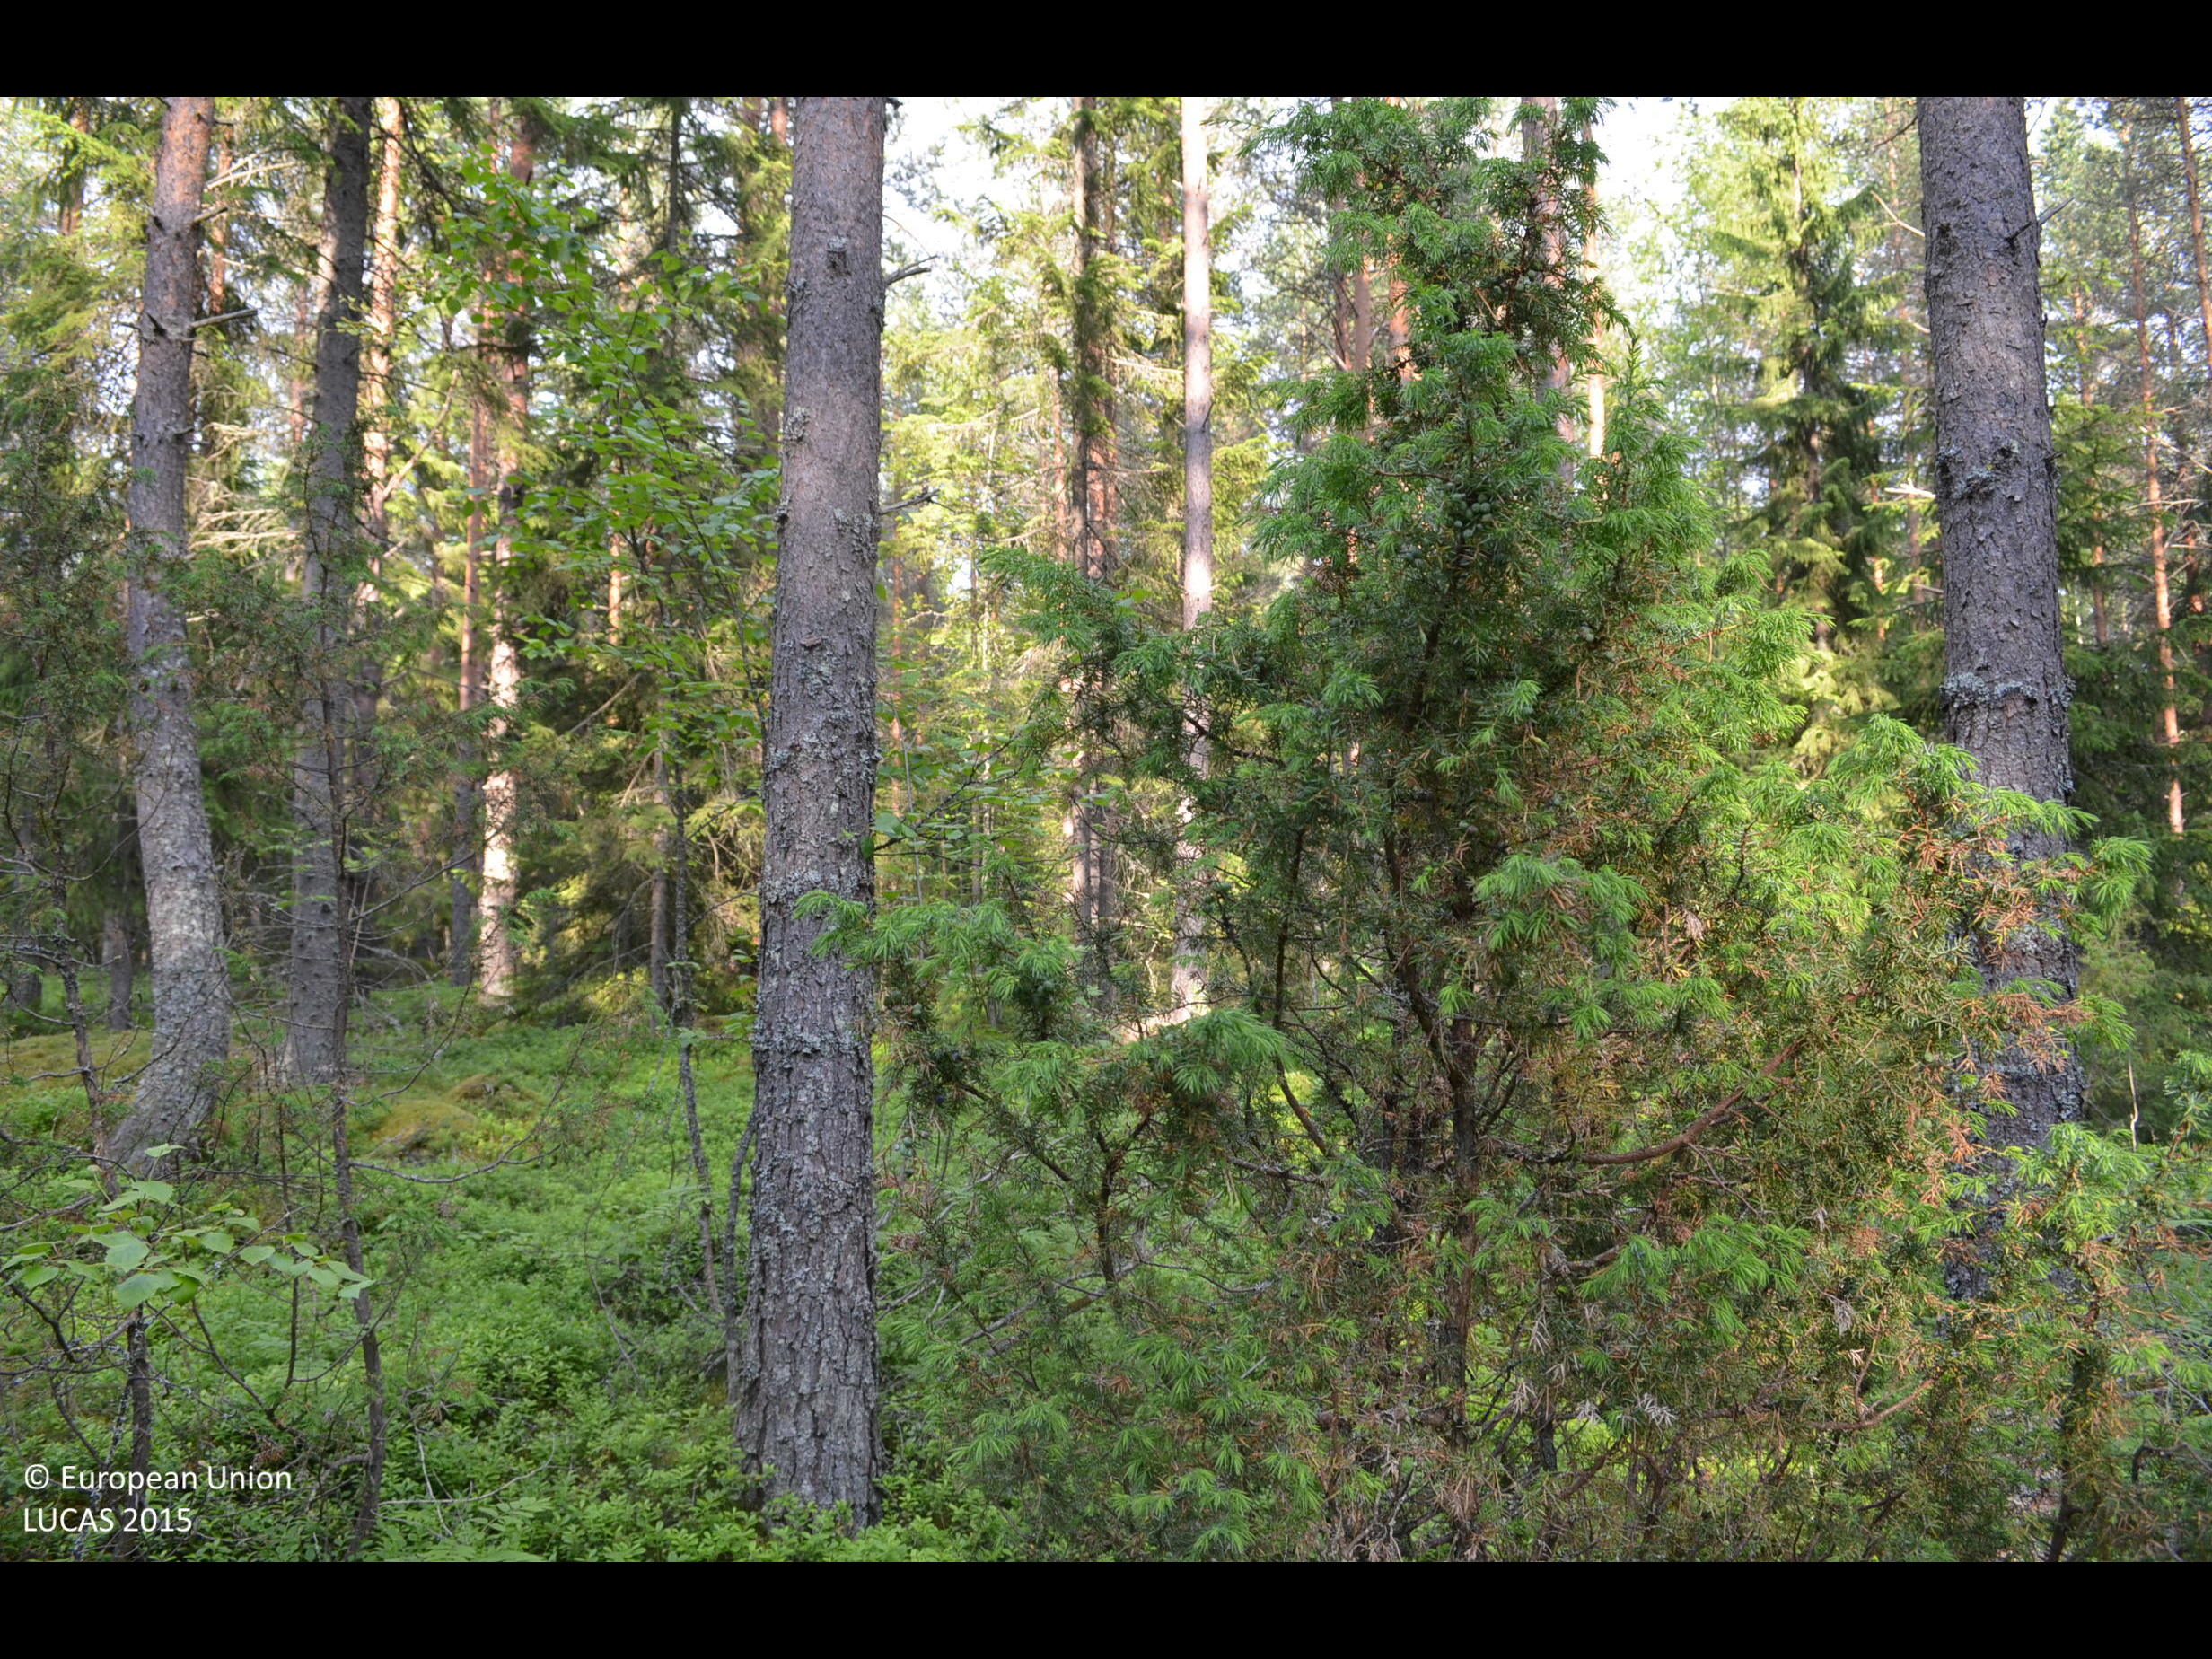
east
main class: Woodland
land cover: Pine dominated coniferous woodland
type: boreal forest
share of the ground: > 75 %
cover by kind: coniferous forest trees 70 %, shrubs 25 %, broadleaved forest trees 5 %
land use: Forestry
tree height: > 5 m
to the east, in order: Pine dominated coniferous woodland; Other mixed woodland; Ditches and canals; Other mixed woodland; Ditches and canals; Other mixed woodland; Ditches and canals; Other mixed woodland; Ditches and canals; Other mixed woodland; Ditches and canals; Other mixed woodland; Ditches and canals; Broadleaved woodland; Other mixed woodland
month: July
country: FI
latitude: 62.2825
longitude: 23.4275
